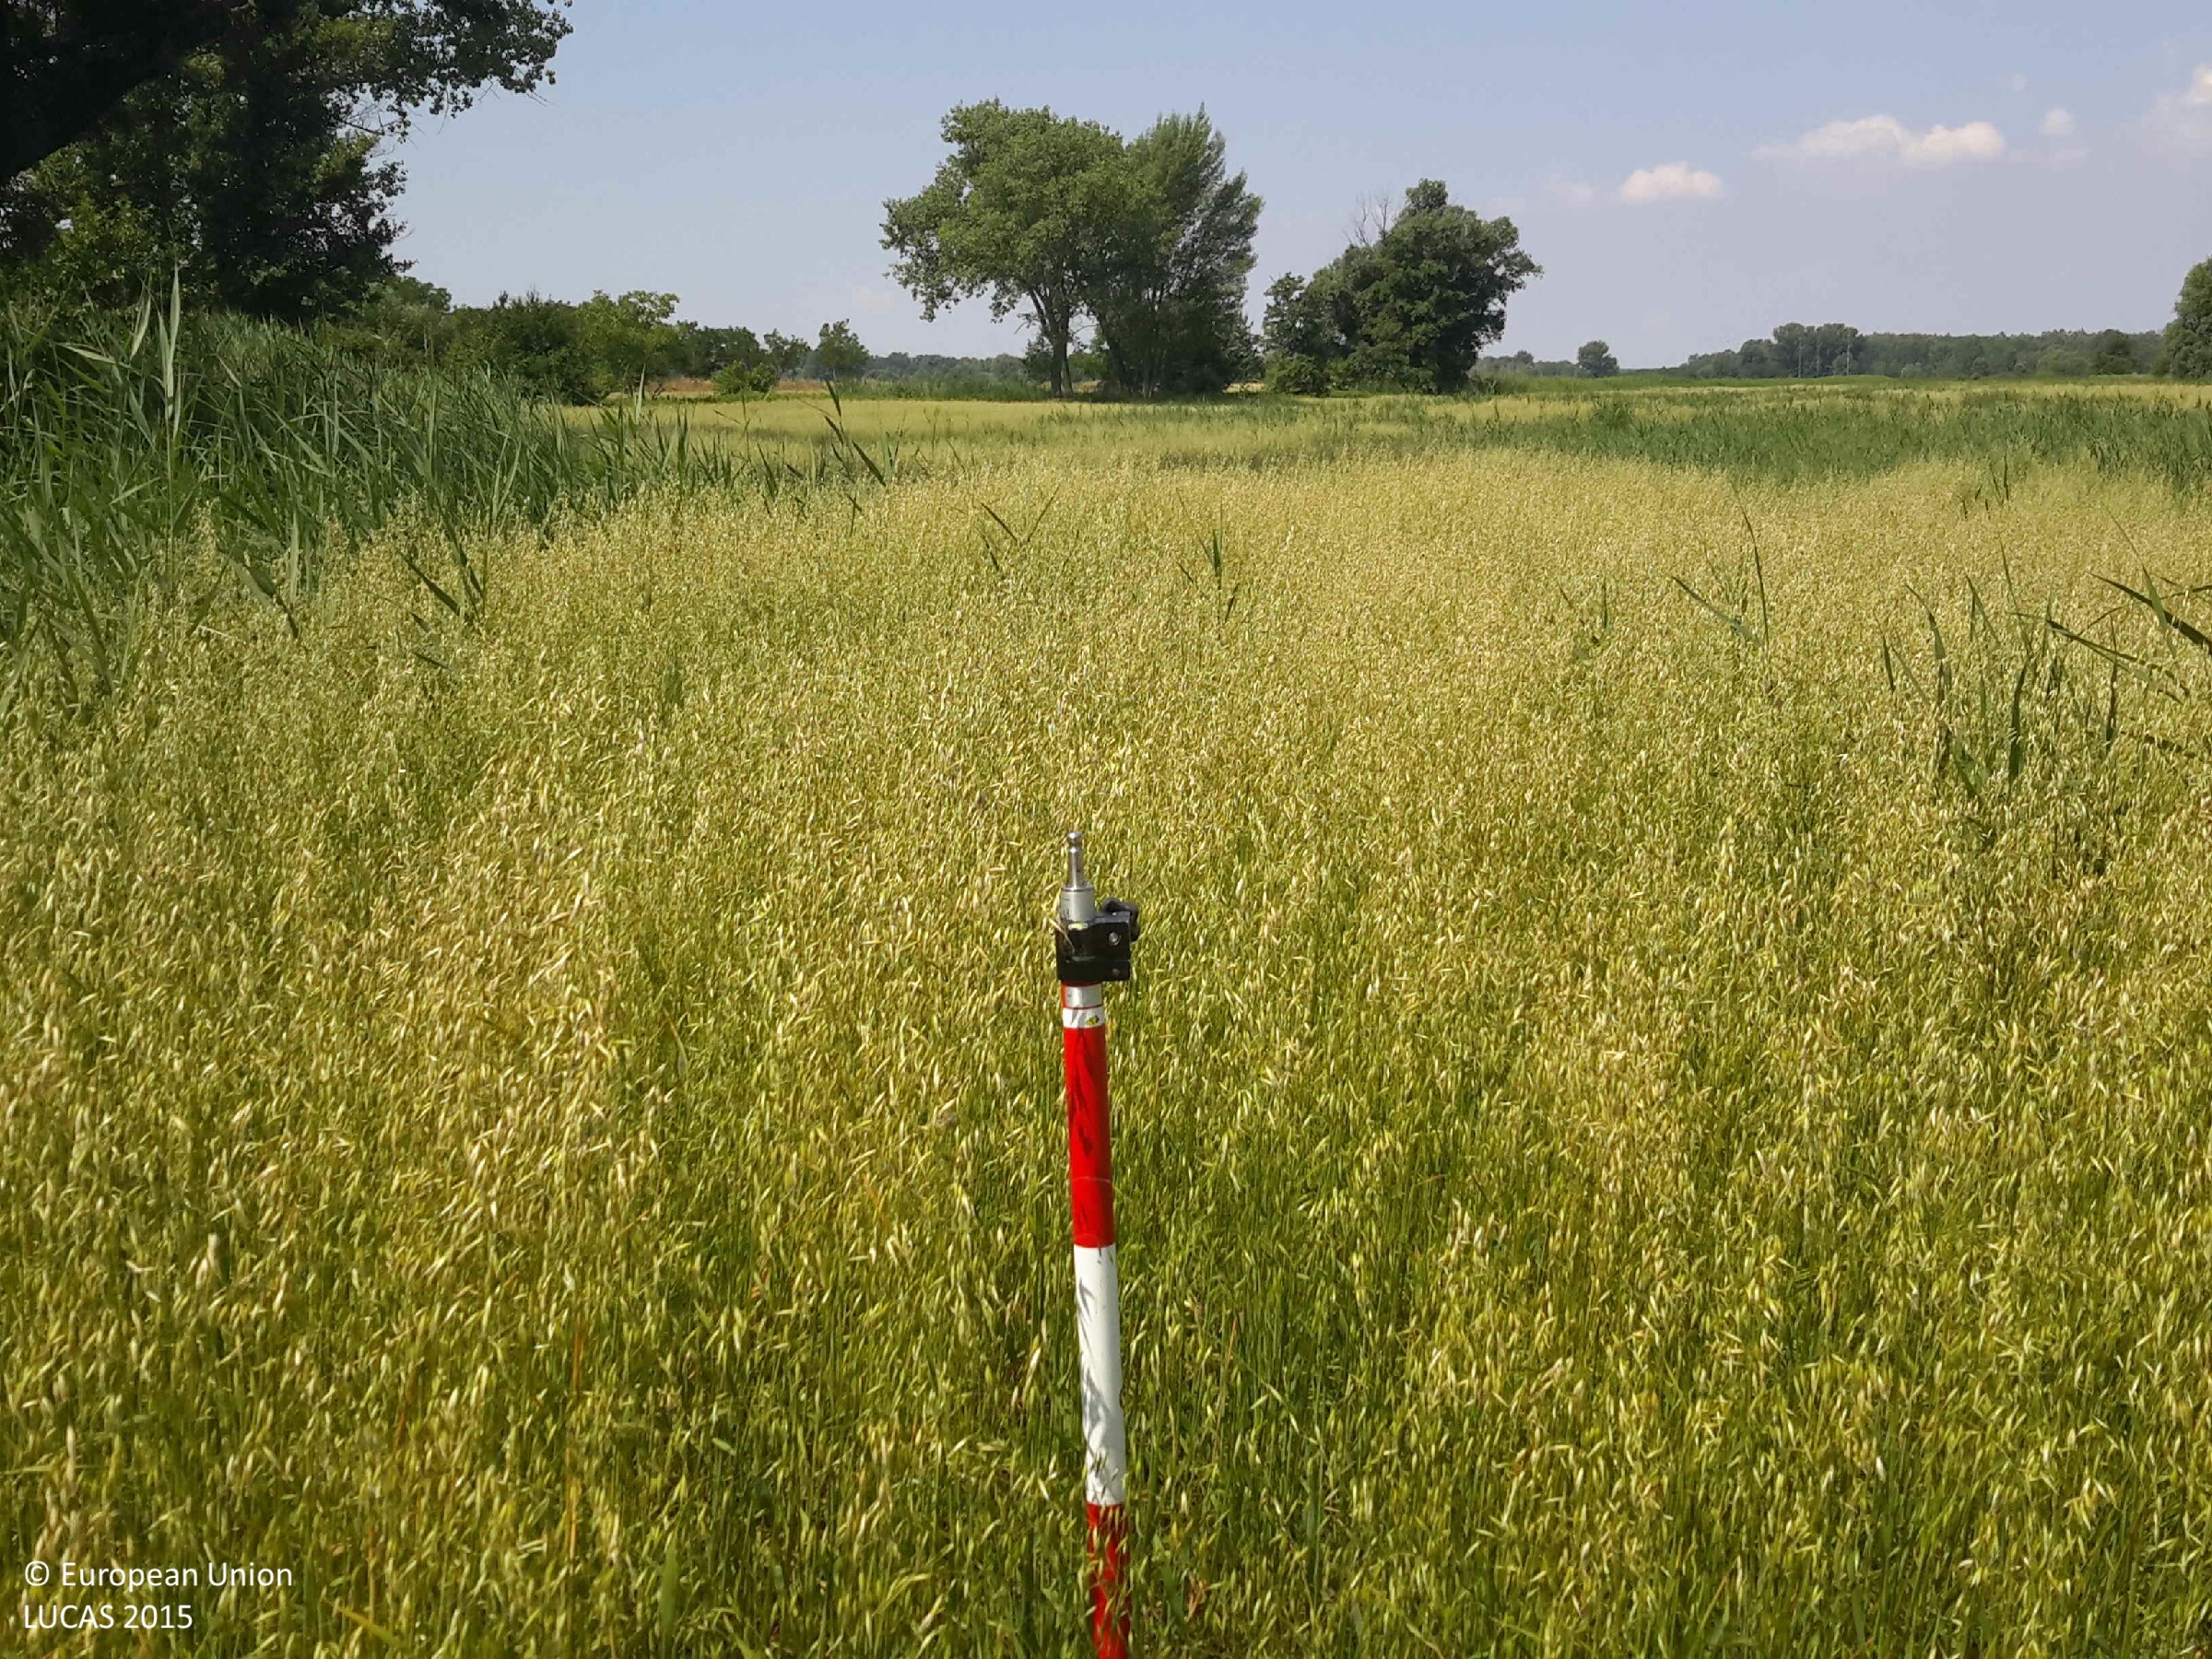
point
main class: Cropland
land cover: Oats
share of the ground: > 75 %
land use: Agriculture (excluding fallow land and kitchen gardens)
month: July
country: HU
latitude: 47.4079
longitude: 17.4952
